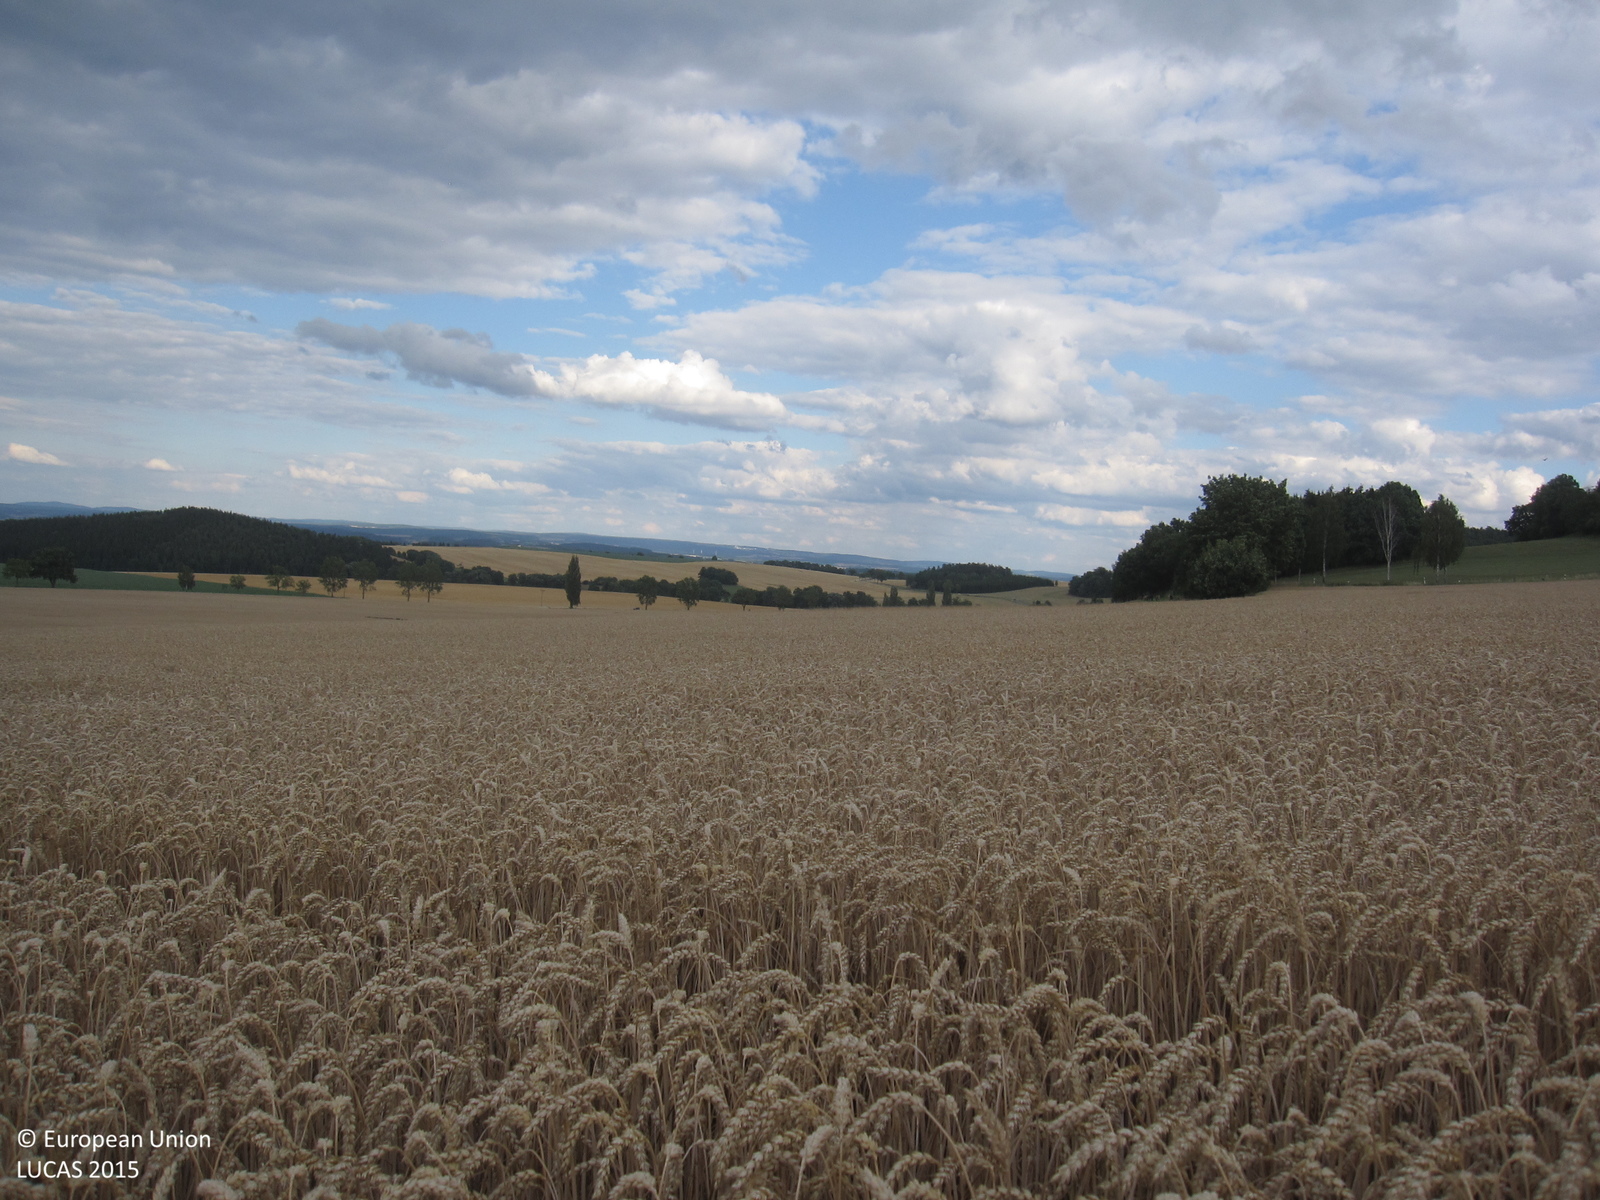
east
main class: Cropland
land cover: Common wheat
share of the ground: > 75 %
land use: Agriculture (excluding fallow land and kitchen gardens)
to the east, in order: Common wheat
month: July
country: DE
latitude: 50.4727
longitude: 11.9863
